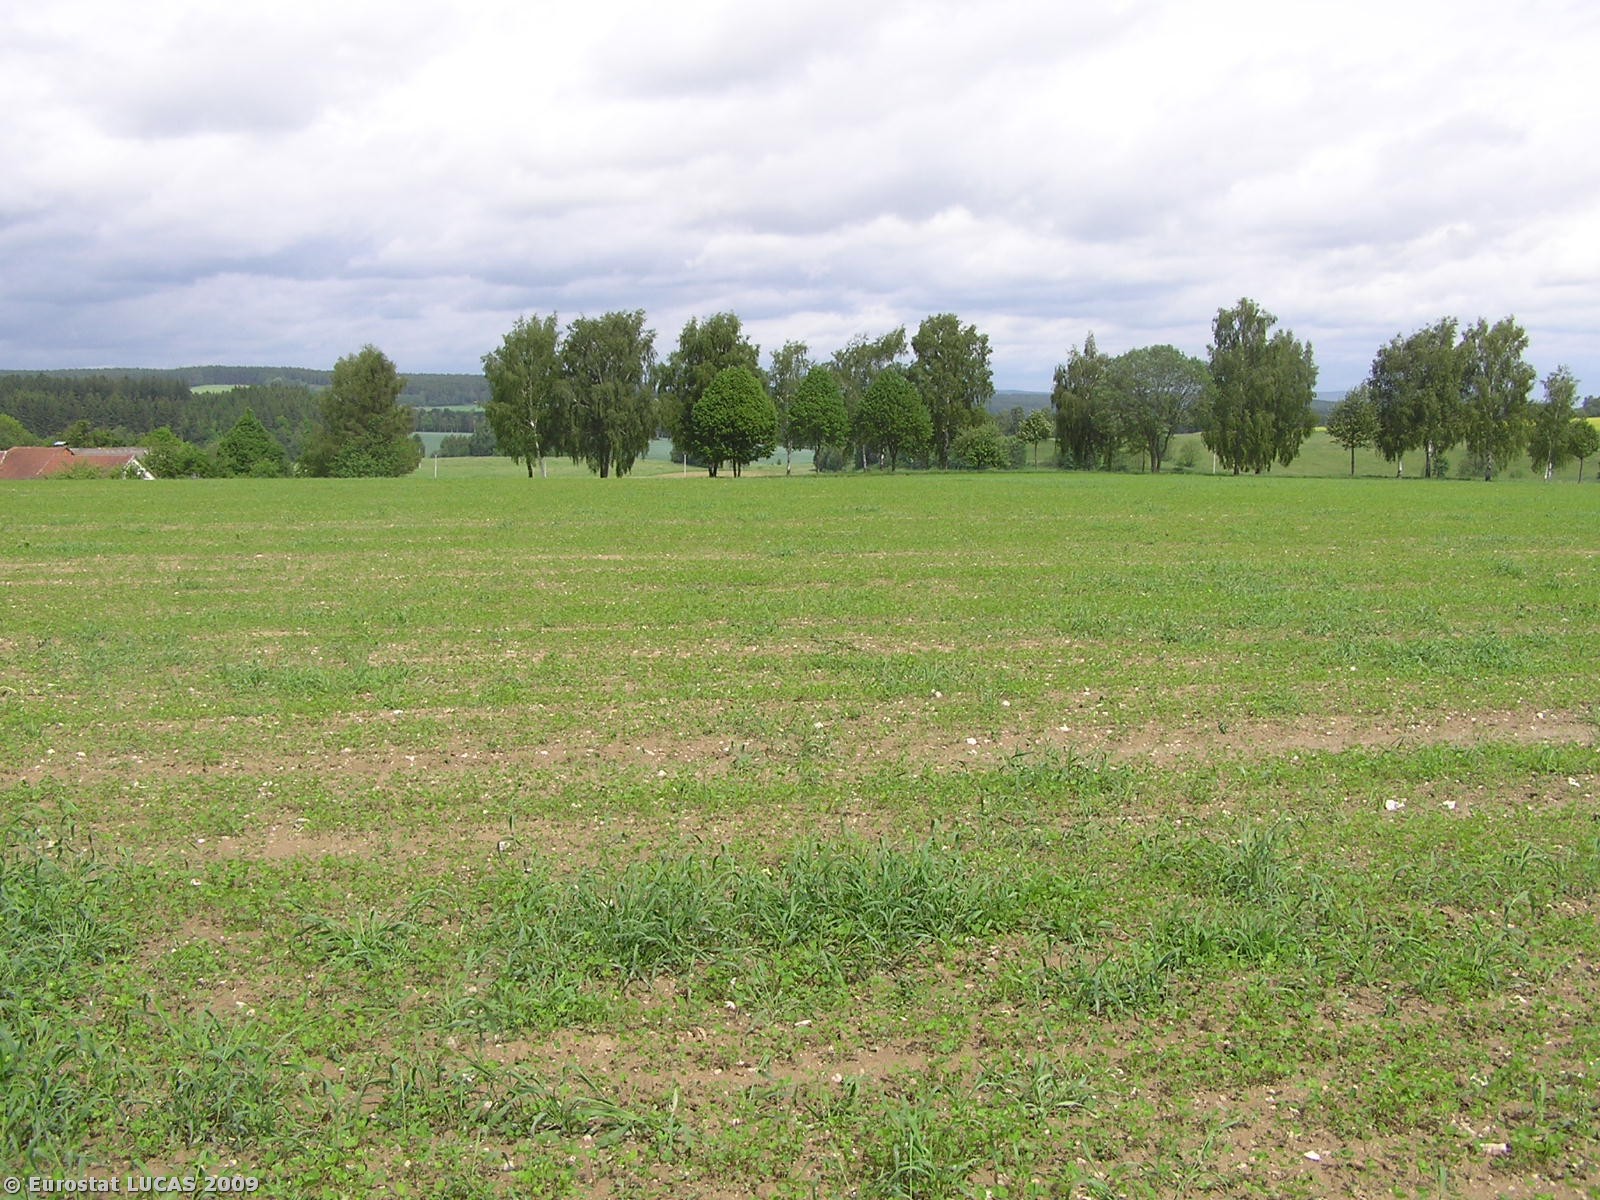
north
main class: Cropland
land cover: Clovers
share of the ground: 50 - 75 %
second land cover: Mixed cereals for fodder
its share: 25 - 50 %
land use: Agriculture (excluding fallow land and kitchen gardens)
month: May
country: CZ
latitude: 49.4089
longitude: 14.9778
